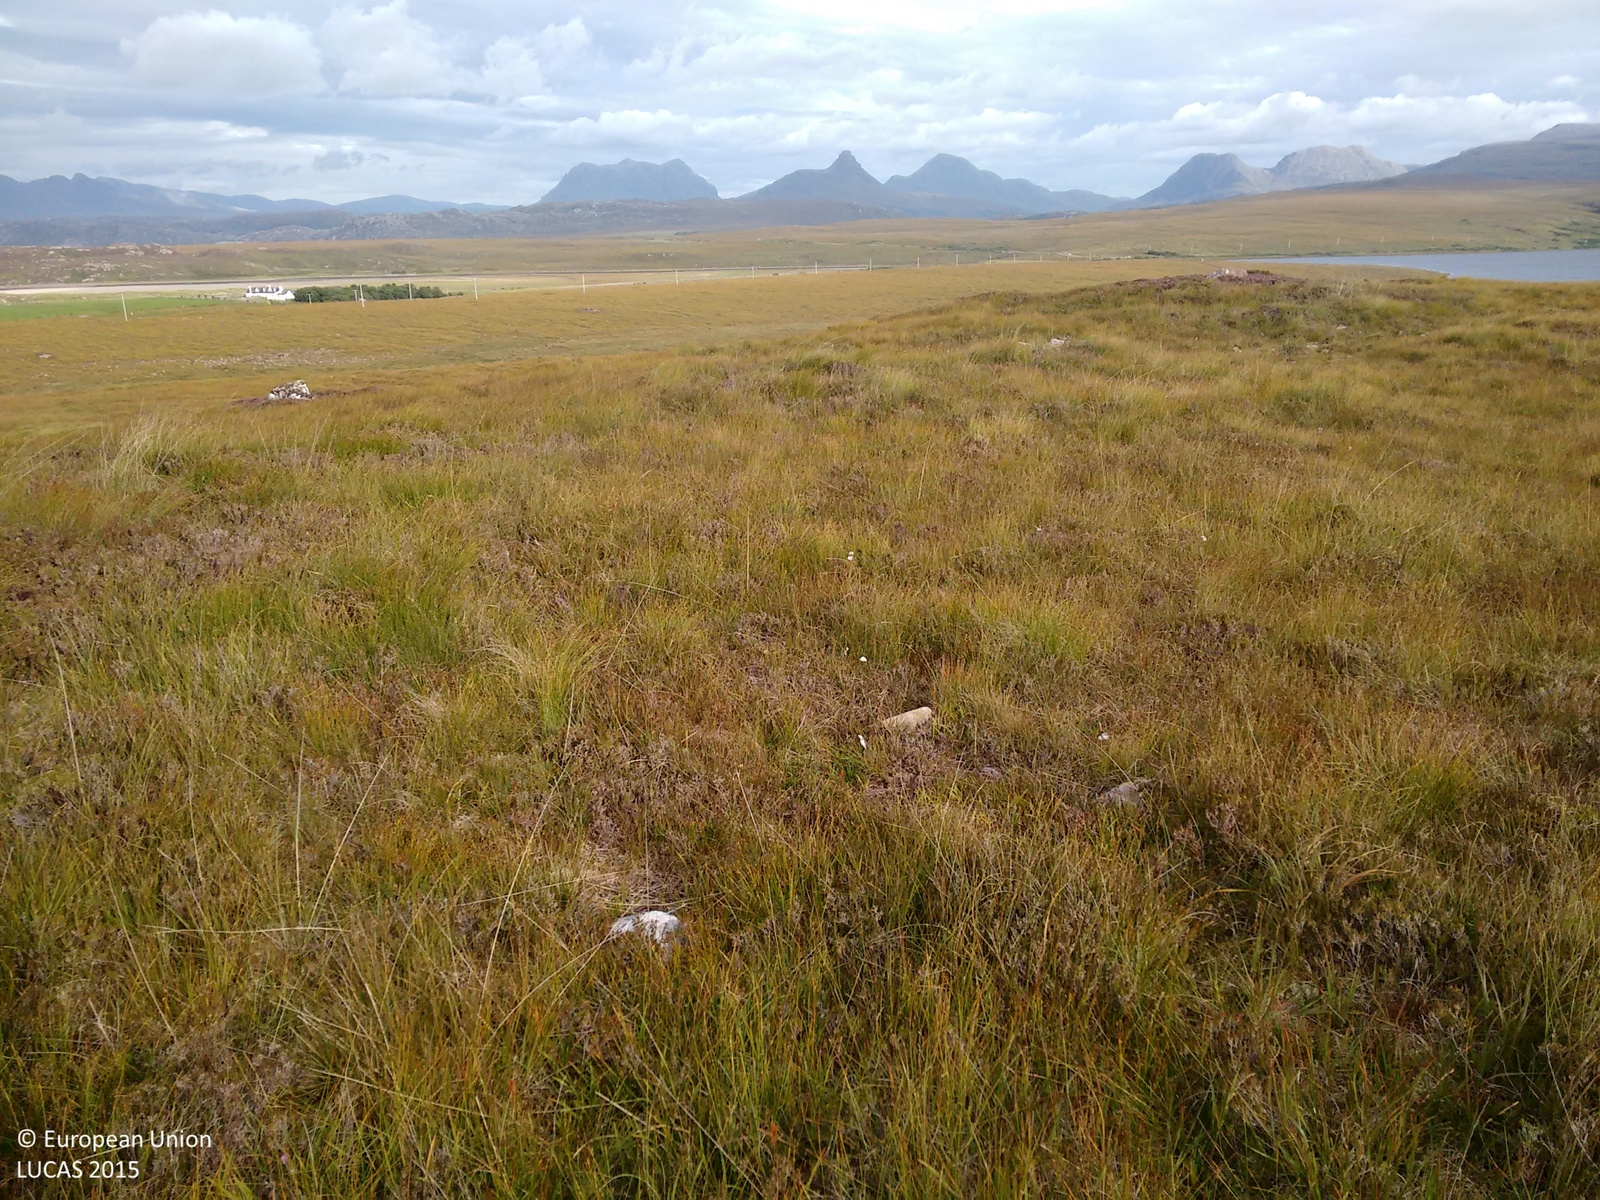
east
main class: Shrubland
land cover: Shrubland without tree cover
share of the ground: > 75 %
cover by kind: shrubs 75 %, herbaceous plants 25 %
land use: Agriculture (excluding fallow land and kitchen gardens)
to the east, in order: Shrubland without tree cover; Grassland without tree/shrub cover
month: September
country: GB
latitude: 58.0611
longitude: -5.3789
